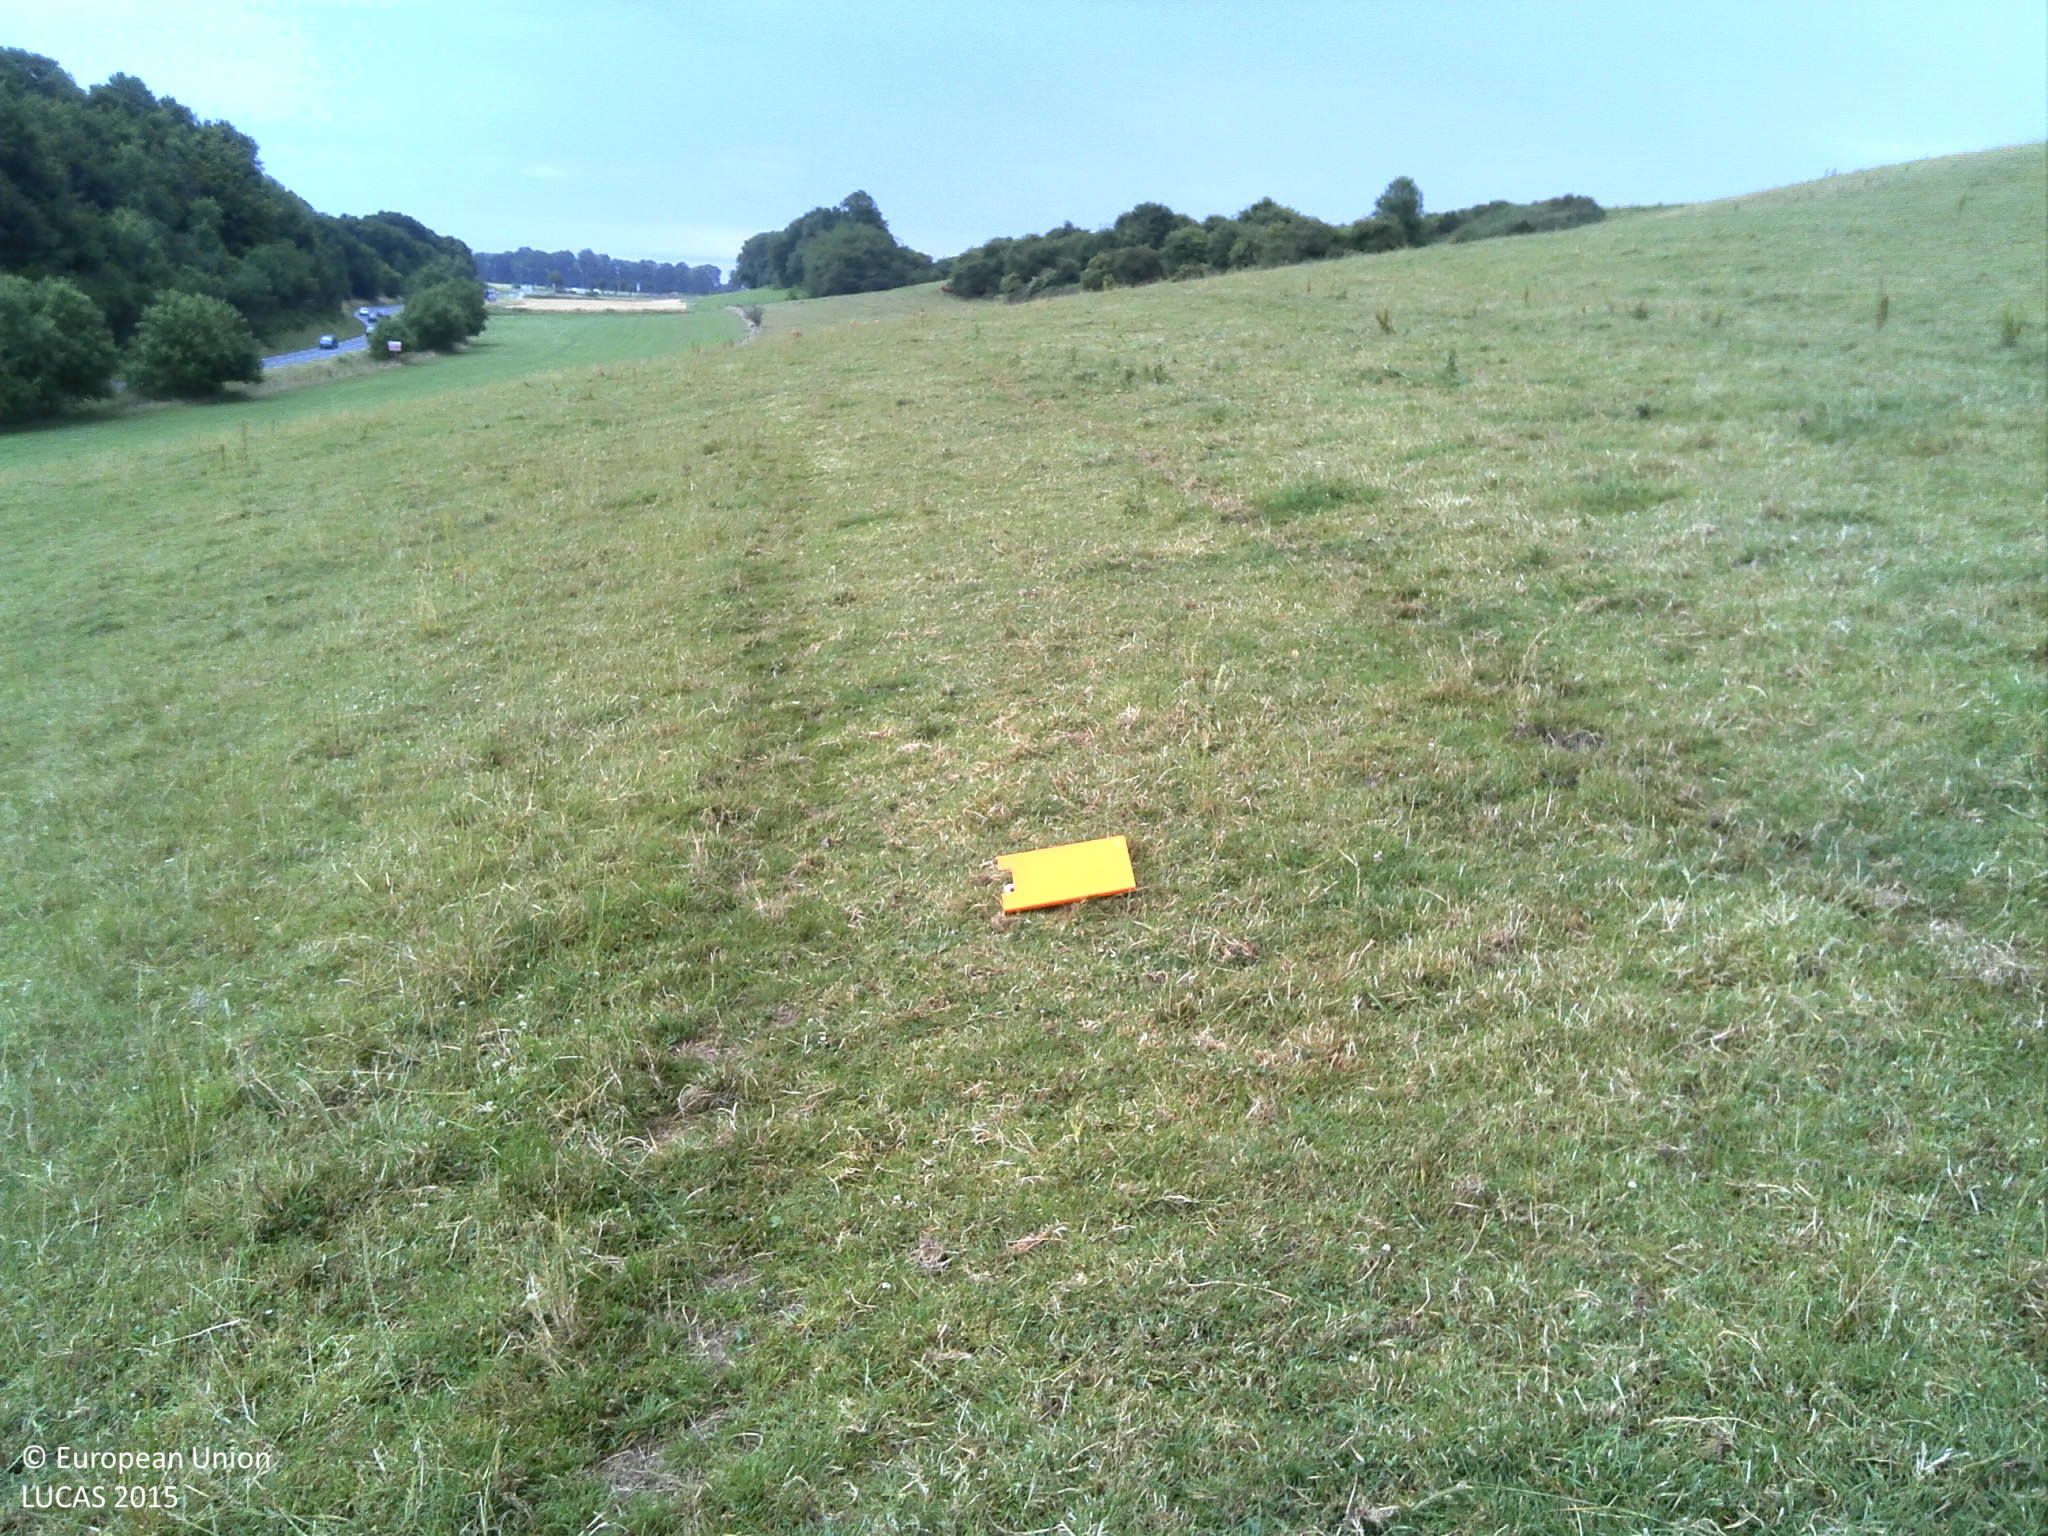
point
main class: Grassland
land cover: Grassland without tree/shrub cover
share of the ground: > 75 %
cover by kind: herbaceous plants 100 %
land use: Agriculture (excluding fallow land and kitchen gardens)
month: July
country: FR
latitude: 49.8708
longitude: 1.0871
